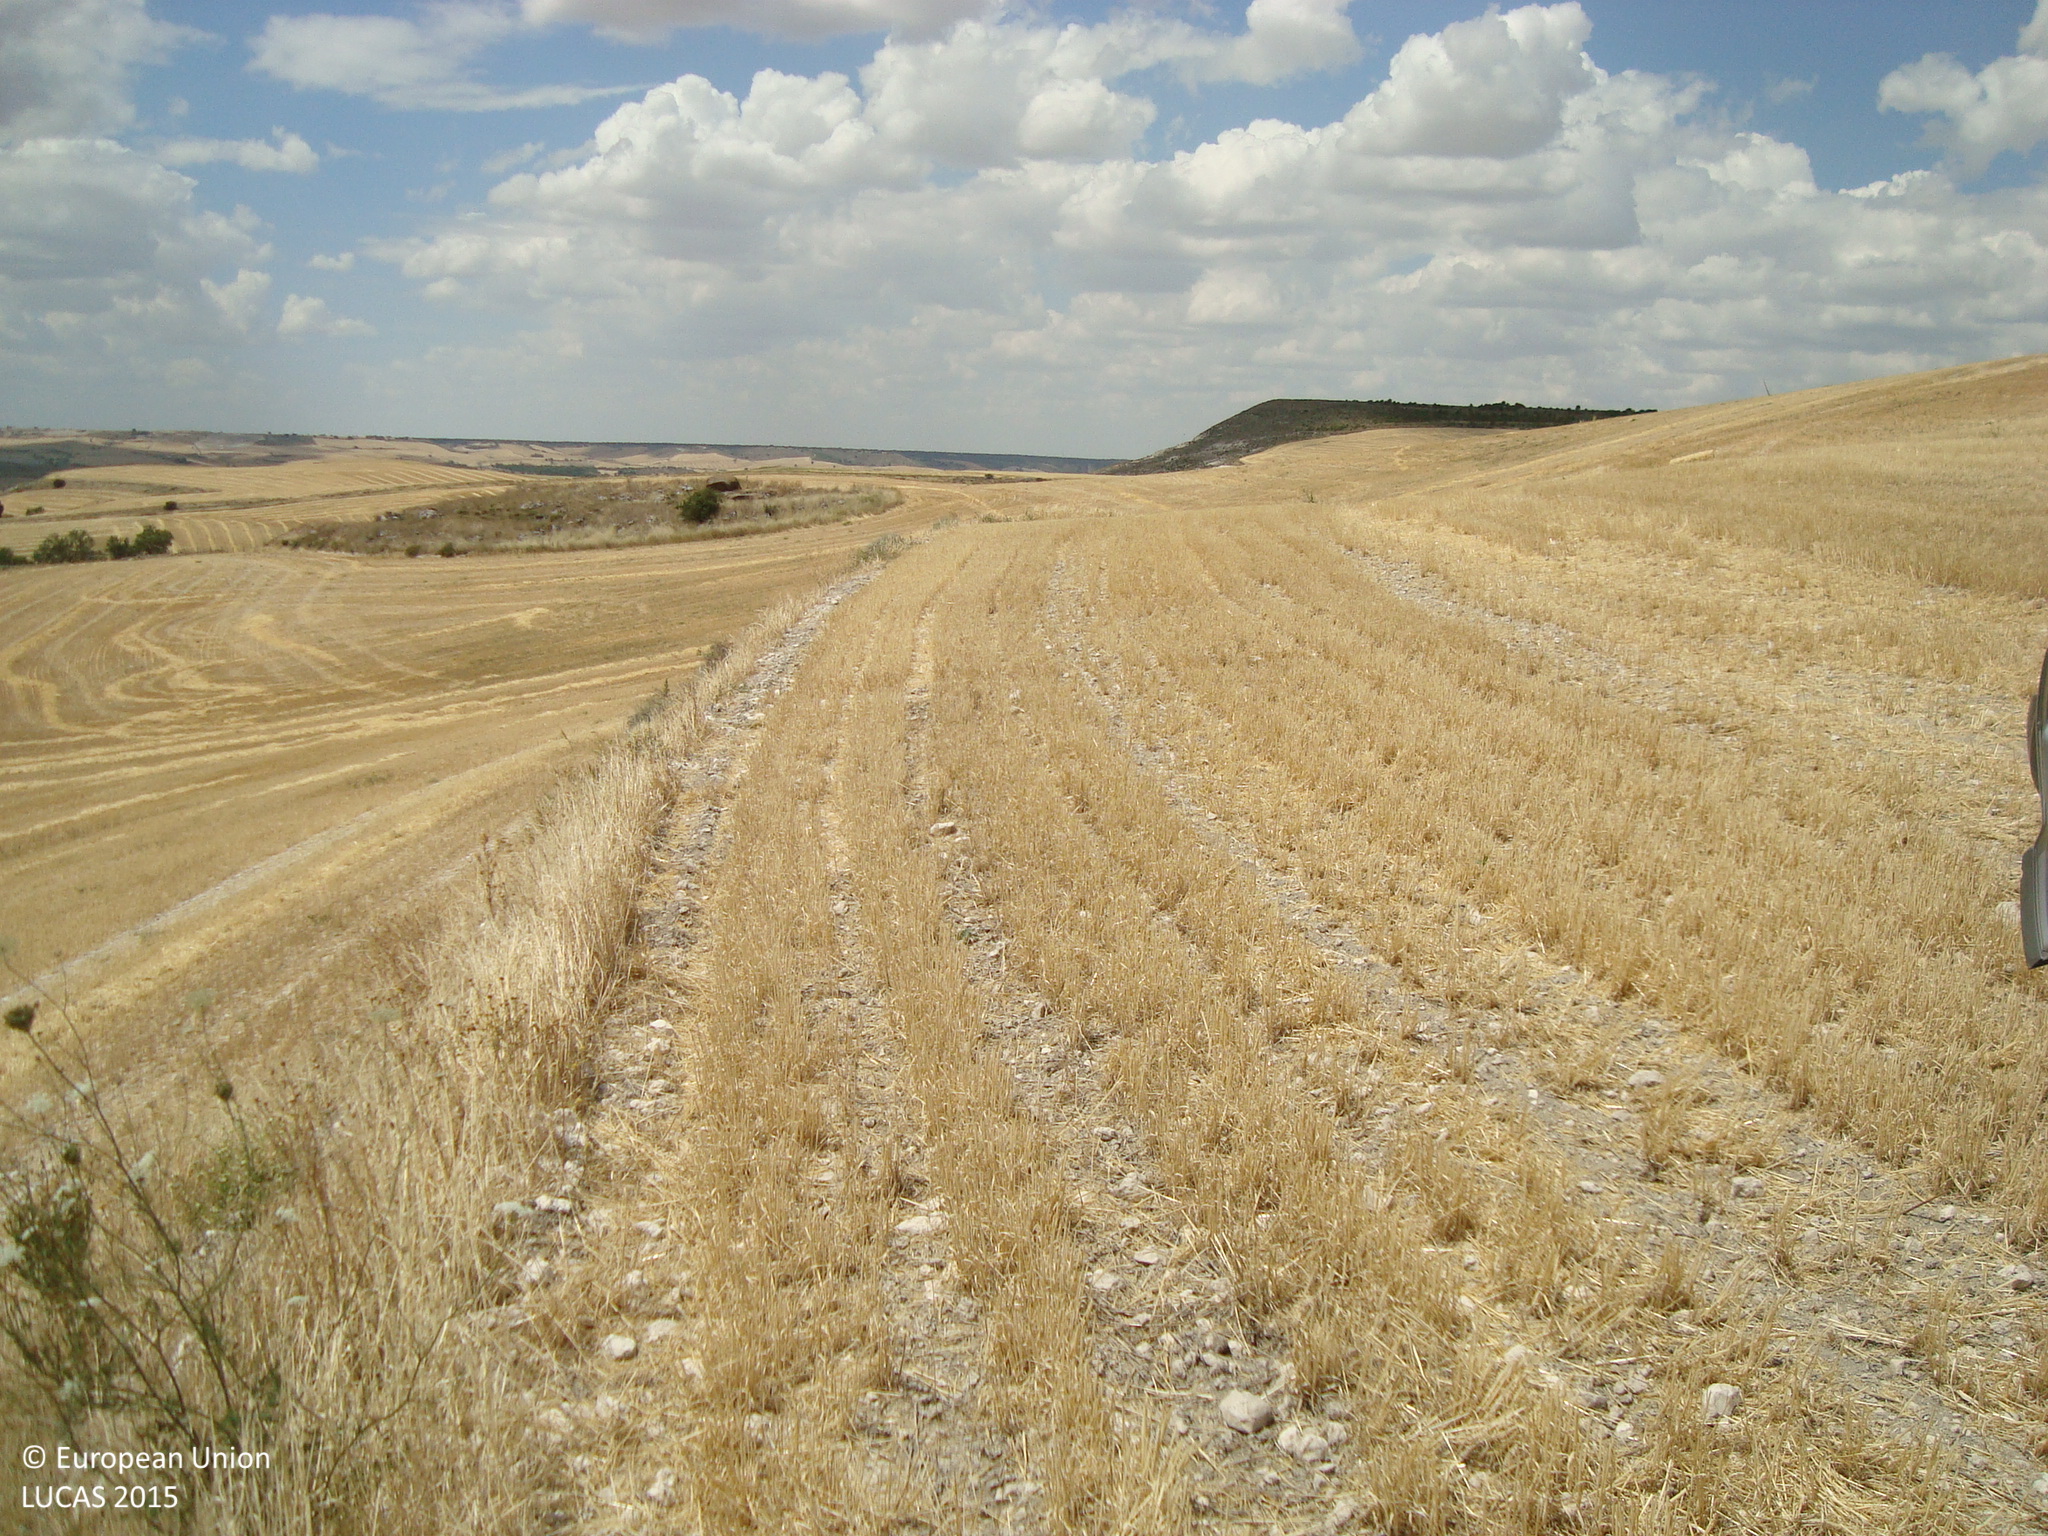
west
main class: Cropland
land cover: Barley
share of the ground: > 75 %
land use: Agriculture (excluding fallow land and kitchen gardens)
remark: Harvested field
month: July
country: ES
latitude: 41.9568
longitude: -4.2161
